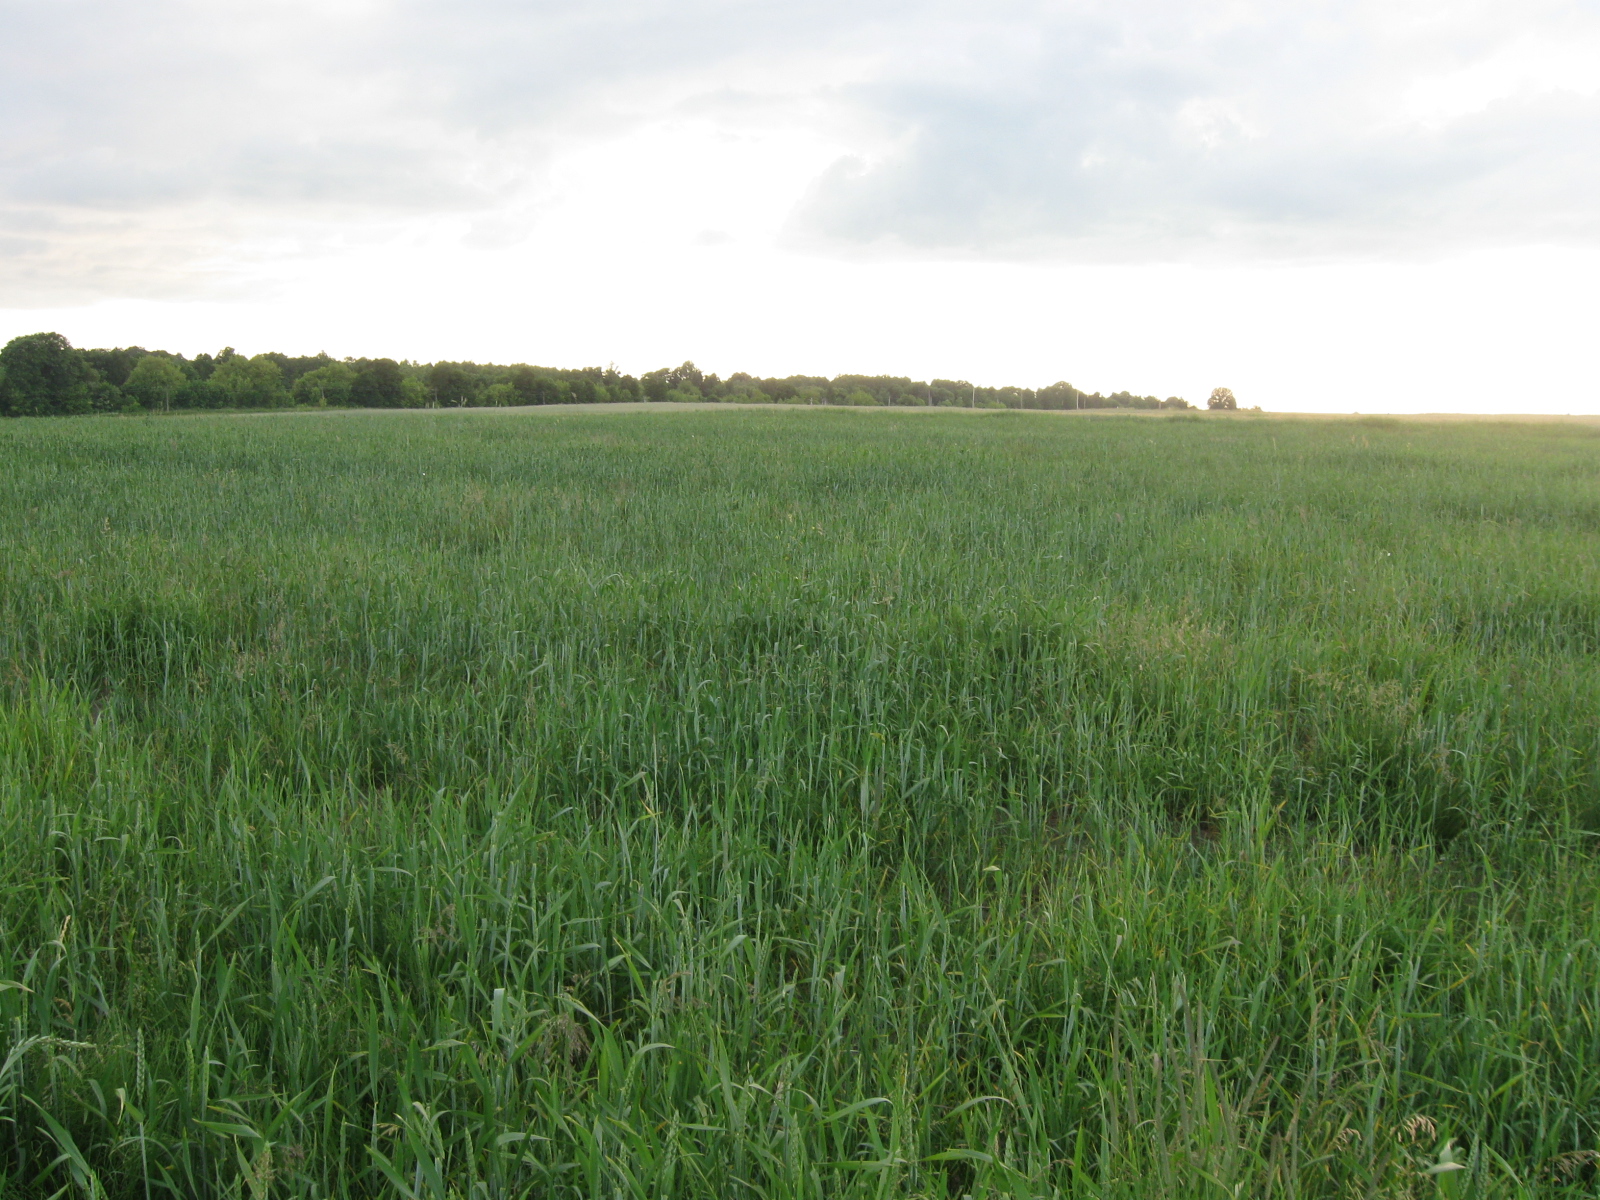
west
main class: Cropland
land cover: Common wheat
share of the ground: > 75 %
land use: Agriculture (excluding fallow land and kitchen gardens)
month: June
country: LT
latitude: 54.8586
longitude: 24.5441
